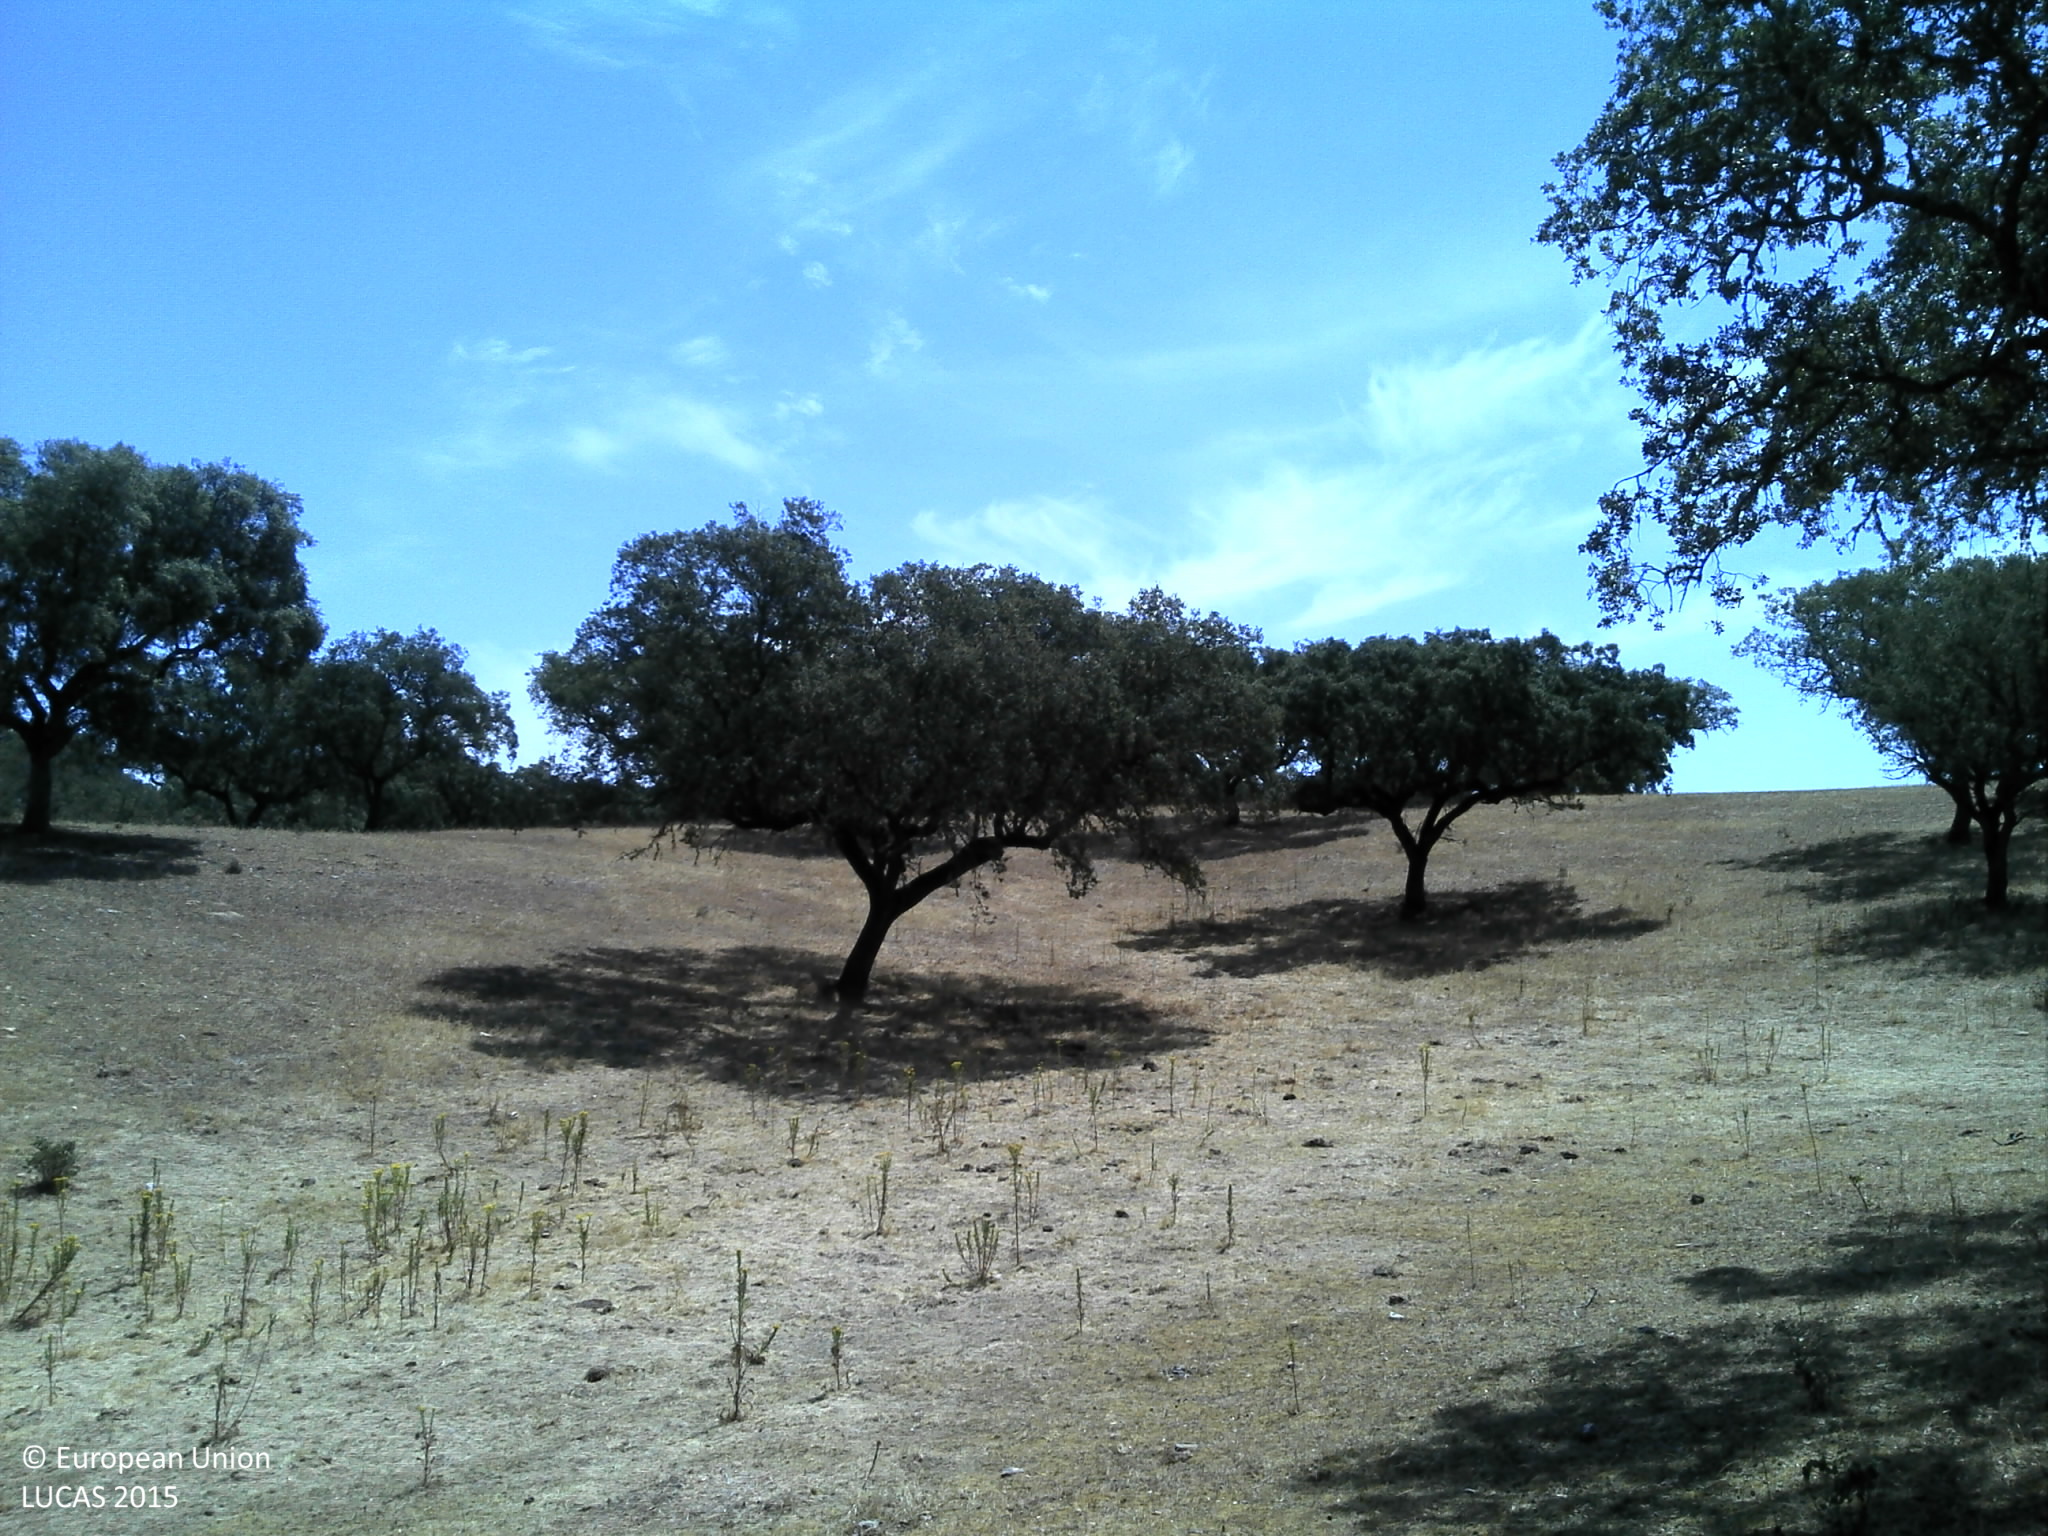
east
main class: Woodland
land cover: Broadleaved woodland
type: broadleaved evergreen forest
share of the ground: 25 - 50 %
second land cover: Grassland without tree/shrub cover
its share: 25 - 50 %
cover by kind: broadleaved forest trees 40 %, unconsolidated bare surface 35 %, herbaceous plants 25 %
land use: Forestry
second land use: Agriculture (excluding fallow land and kitchen gardens)
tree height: > 5 m
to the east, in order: Broadleaved woodland; Grassland without tree/shrub cover; Broadleaved woodland; Tracks; Broadleaved woodland
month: July
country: PT
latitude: 38.4819
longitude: -7.6746
